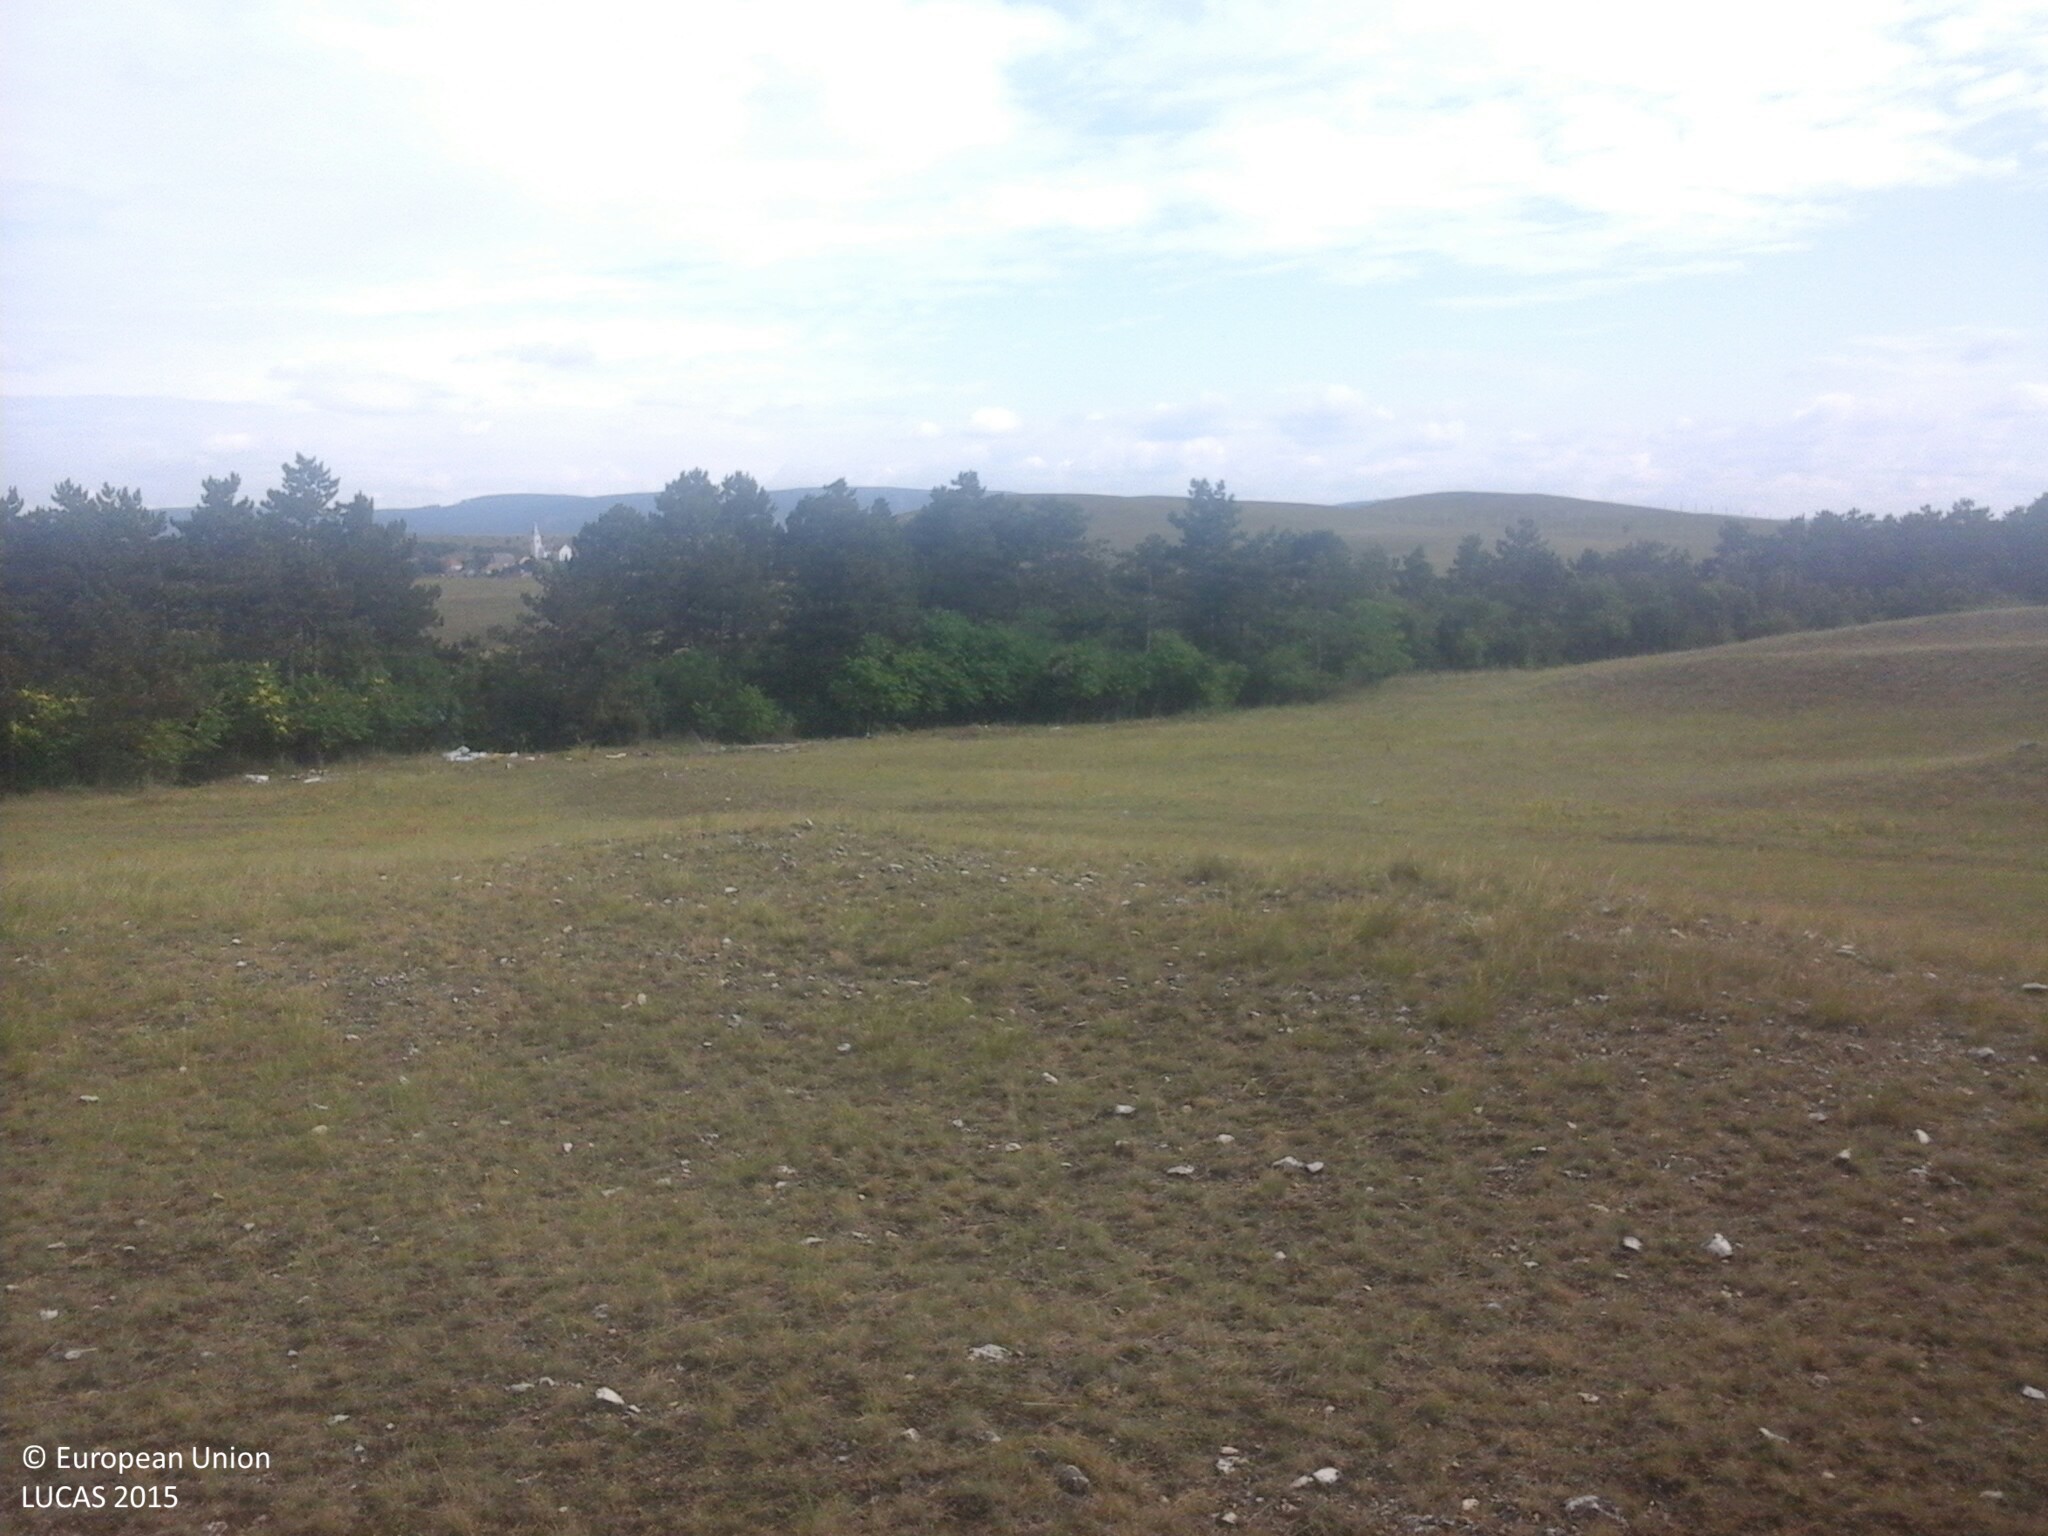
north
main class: Grassland
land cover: Grassland without tree/shrub cover
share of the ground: > 75 %
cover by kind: herbaceous plants 80 %, consolidated bare surface 20 %
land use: Semi-natural and natural areas not in use
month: July
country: HU
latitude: 47.1358
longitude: 18.0127
